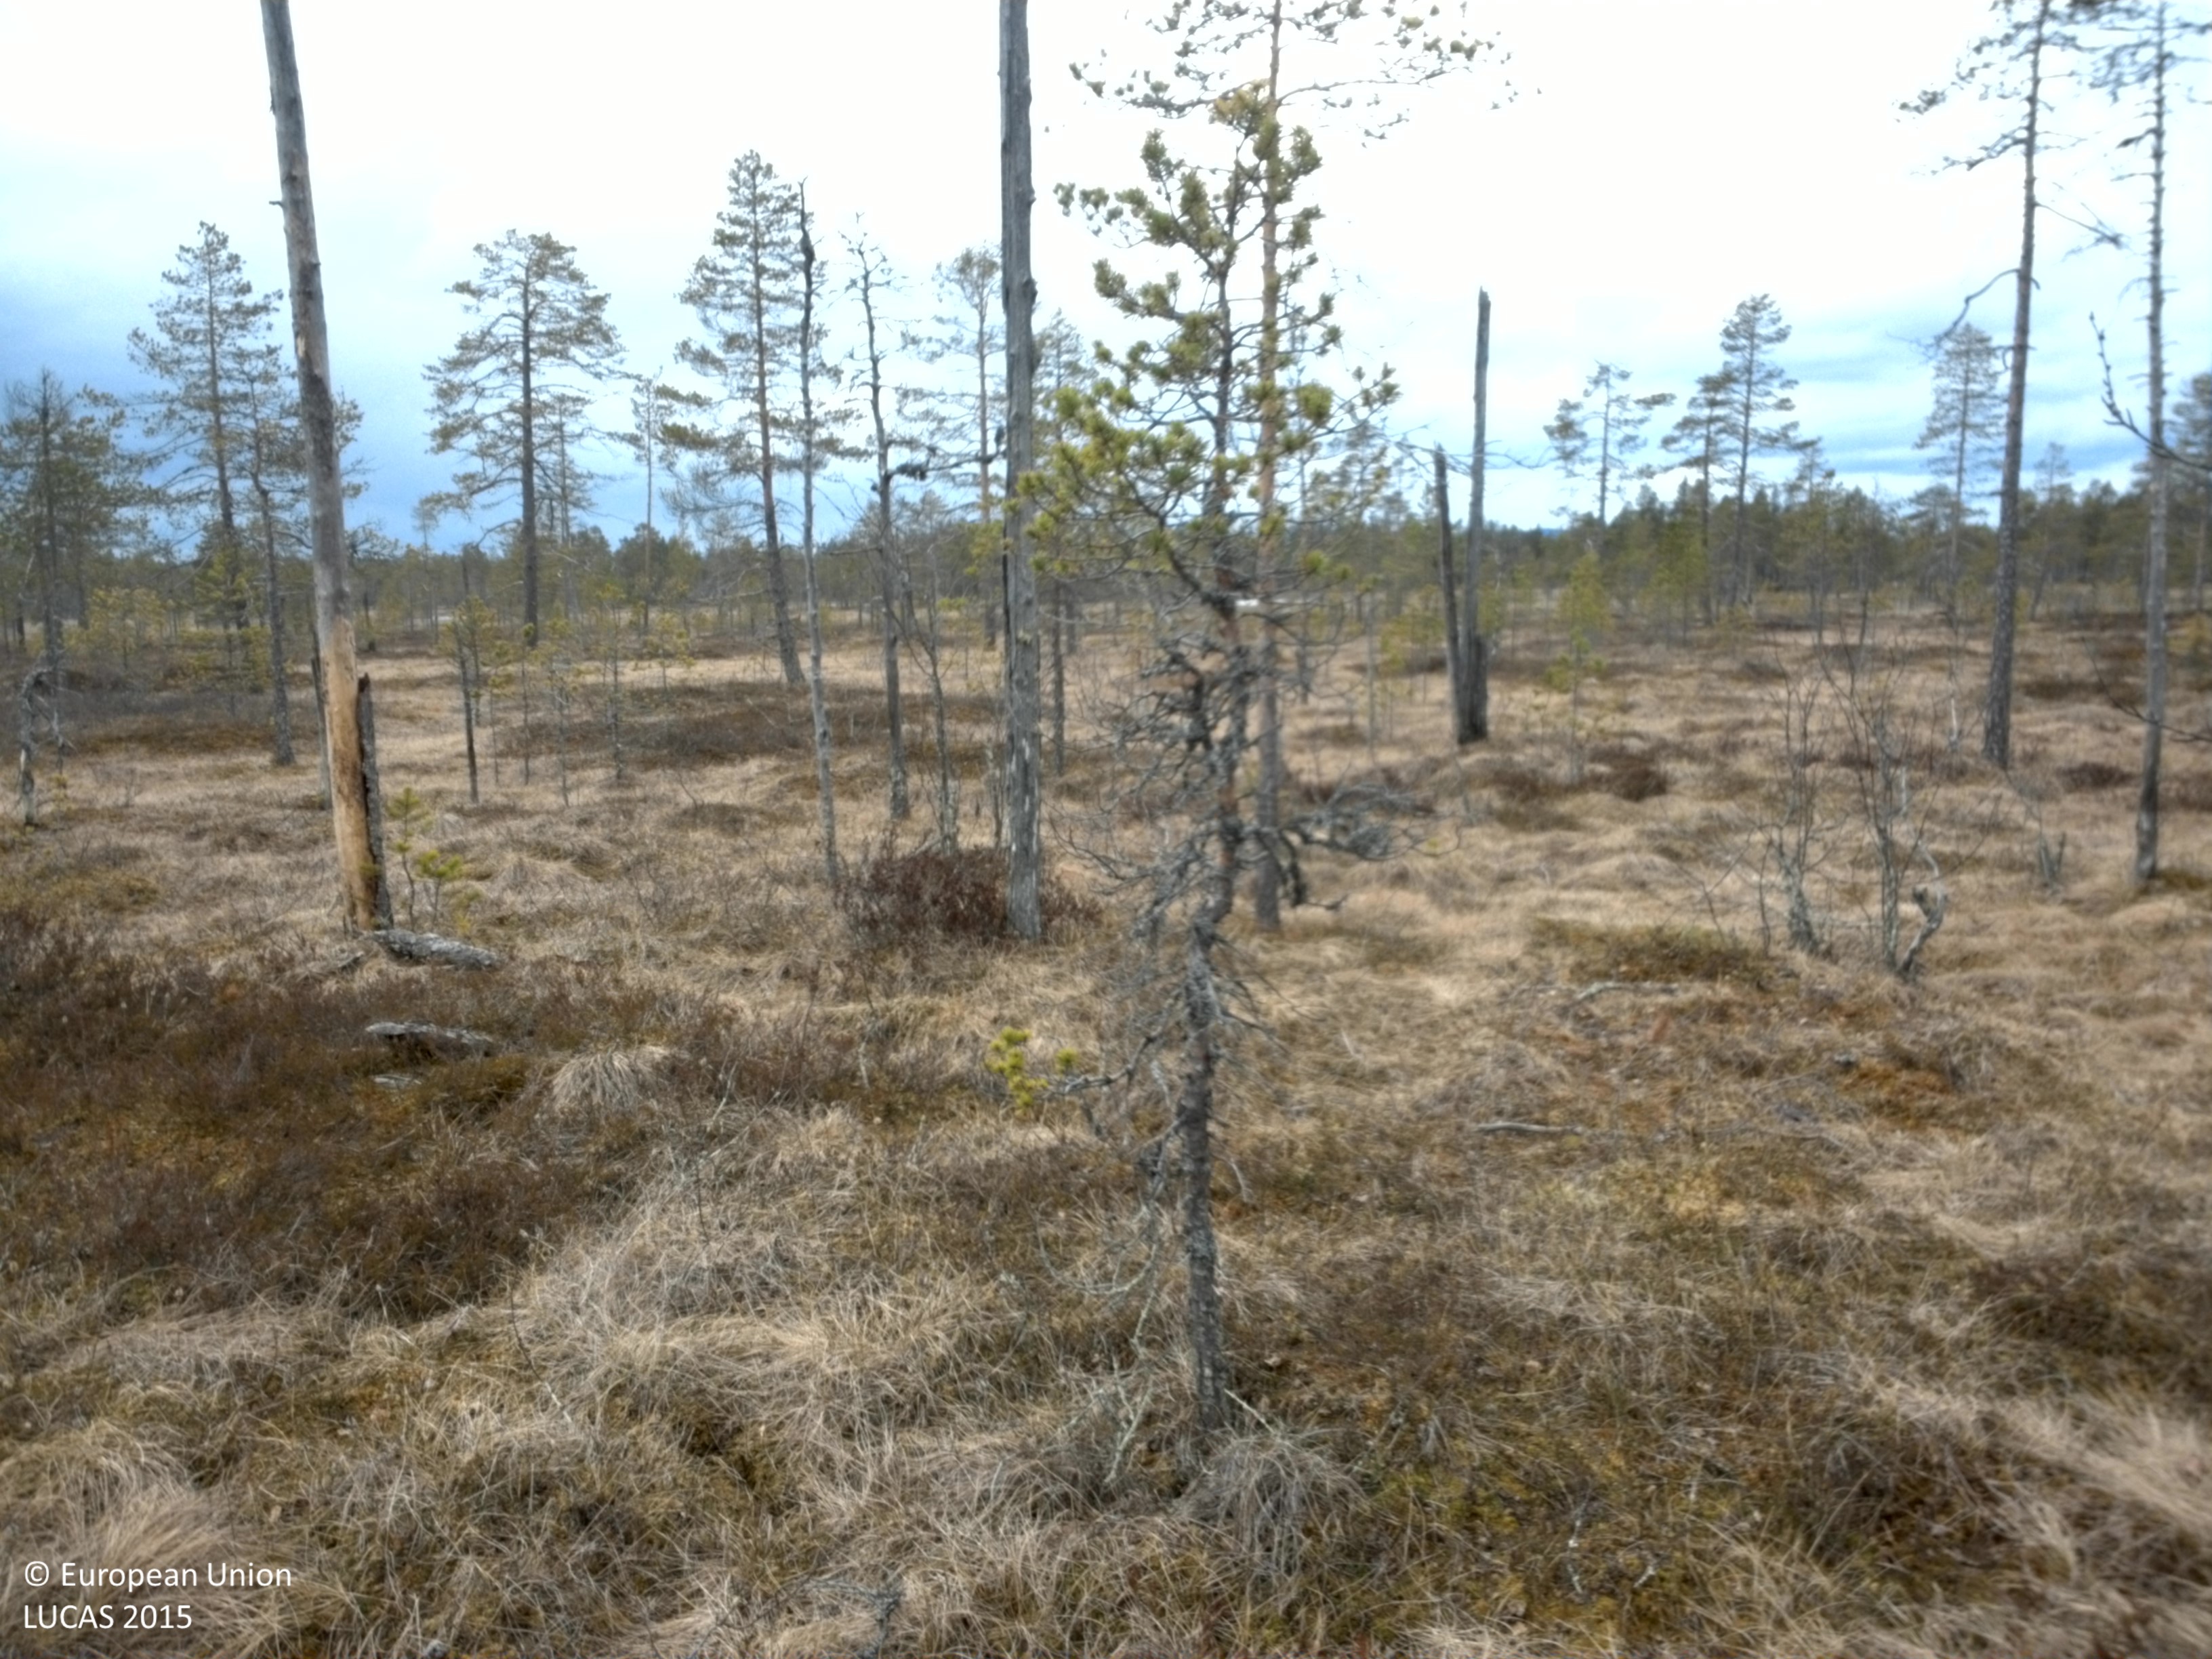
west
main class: Woodland
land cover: Pine dominated coniferous woodland
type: boreal forest
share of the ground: 25 - 50 %
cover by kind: herbaceous plants 40 %, shrubs 35 %, coniferous forest trees 25 %
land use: Forestry
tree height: > 5 m
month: May
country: SE
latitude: 60.9992
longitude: 13.6308
